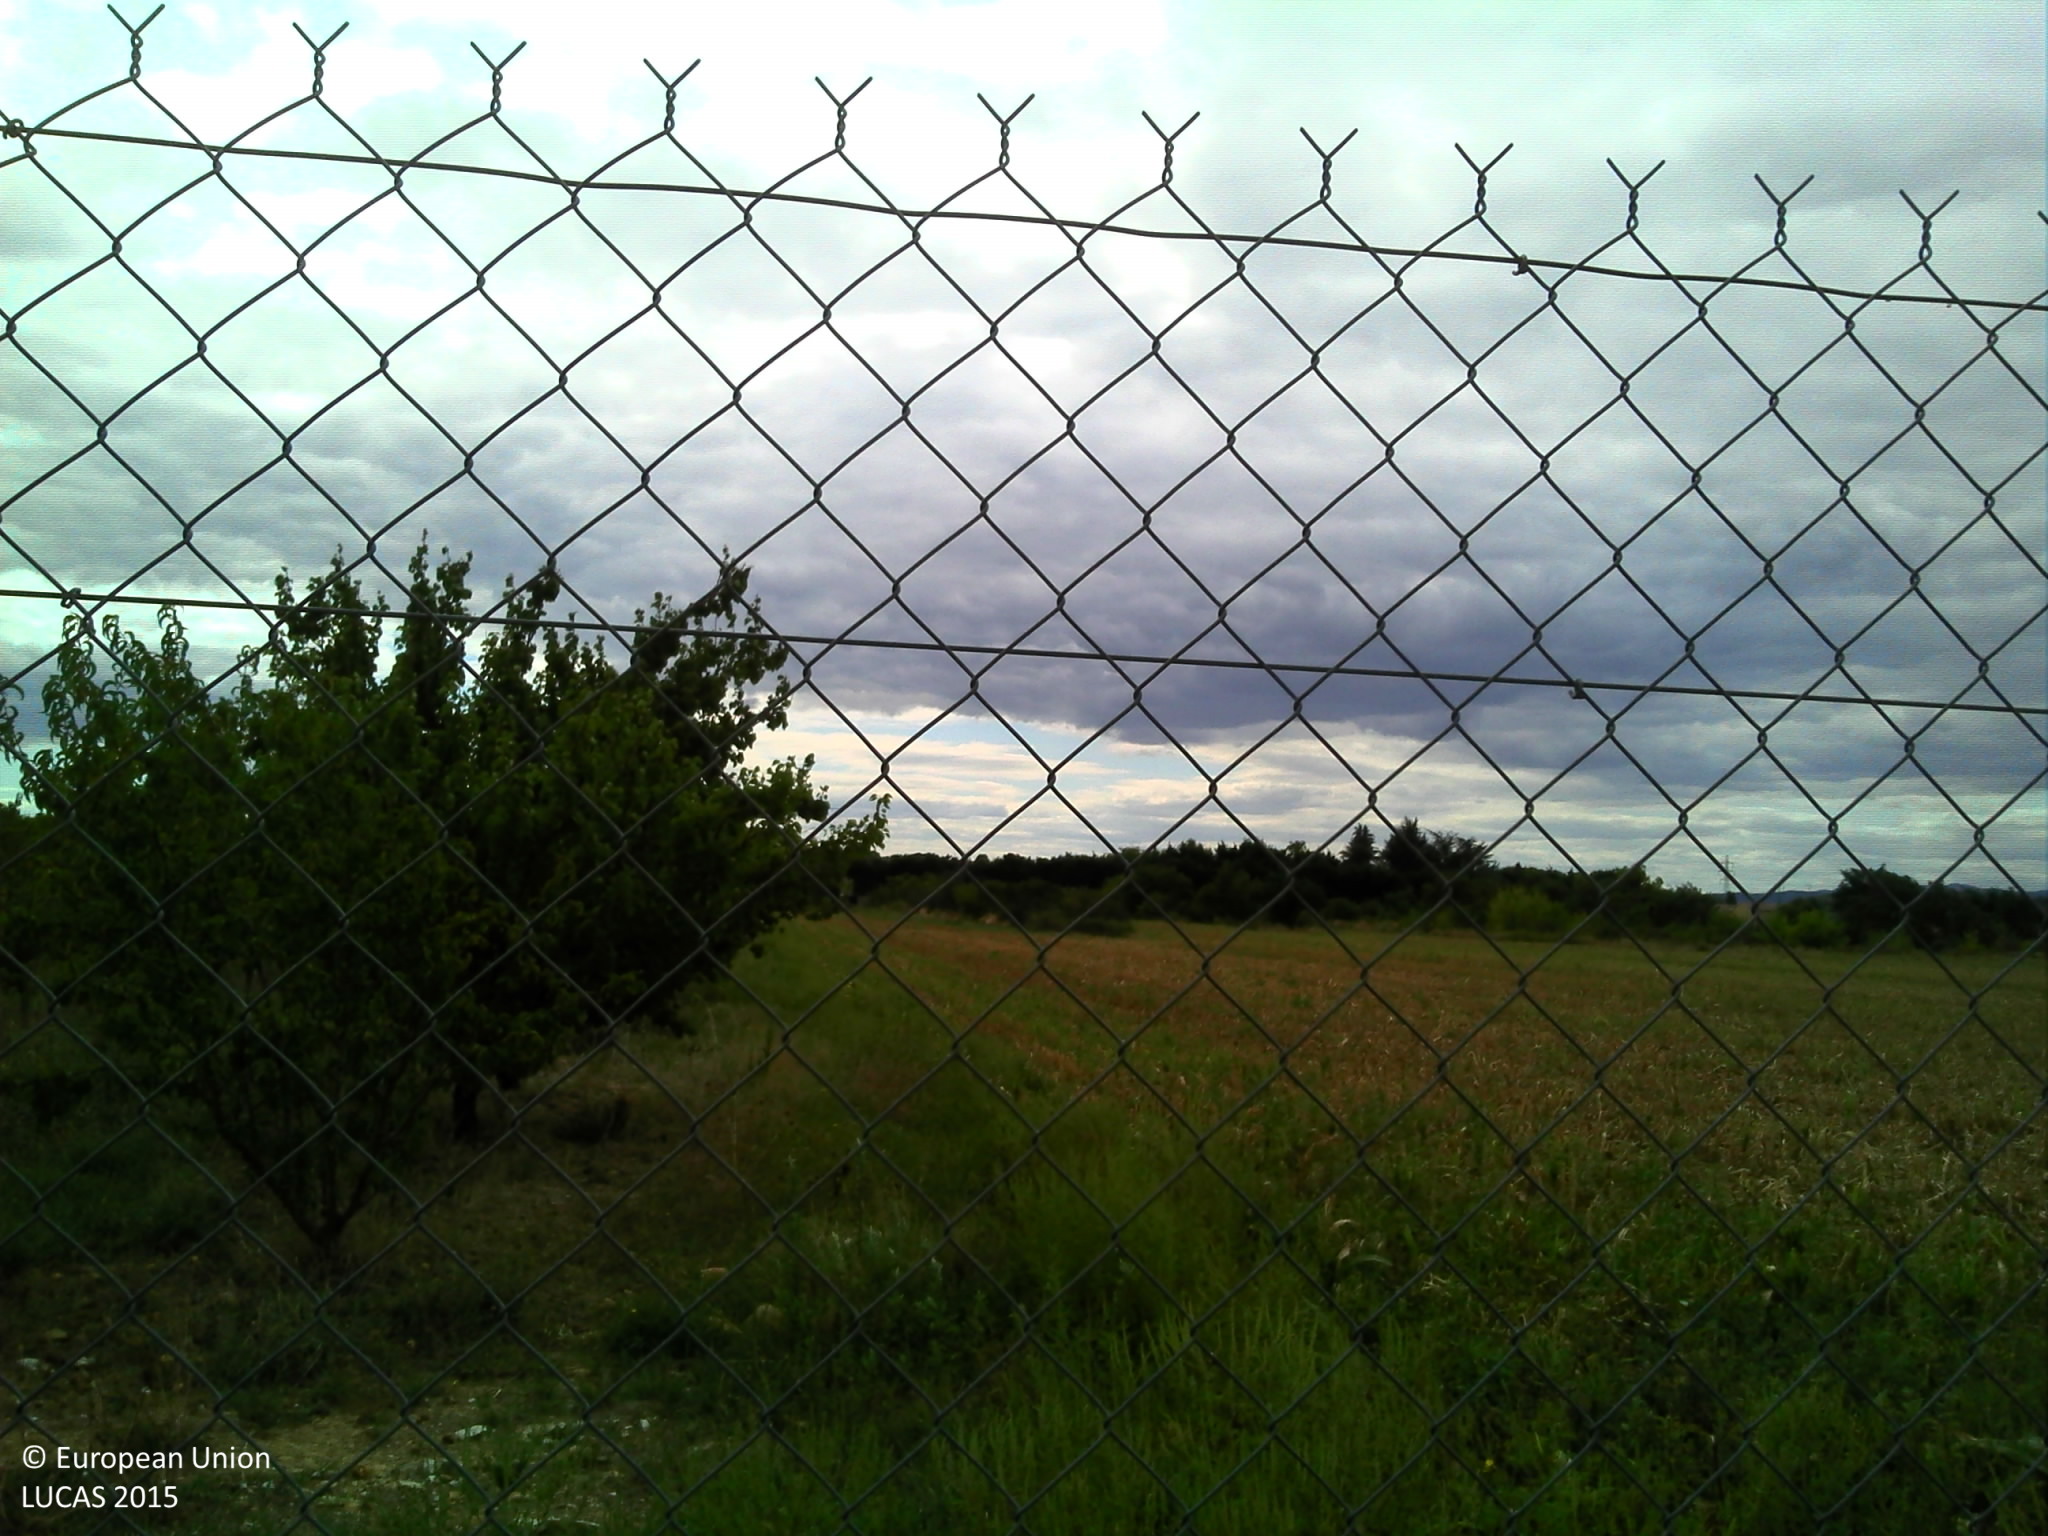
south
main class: Cropland
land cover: Maize
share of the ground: > 75 %
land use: Agriculture (excluding fallow land and kitchen gardens)
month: September
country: FR
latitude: 44.9130
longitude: 4.9265
